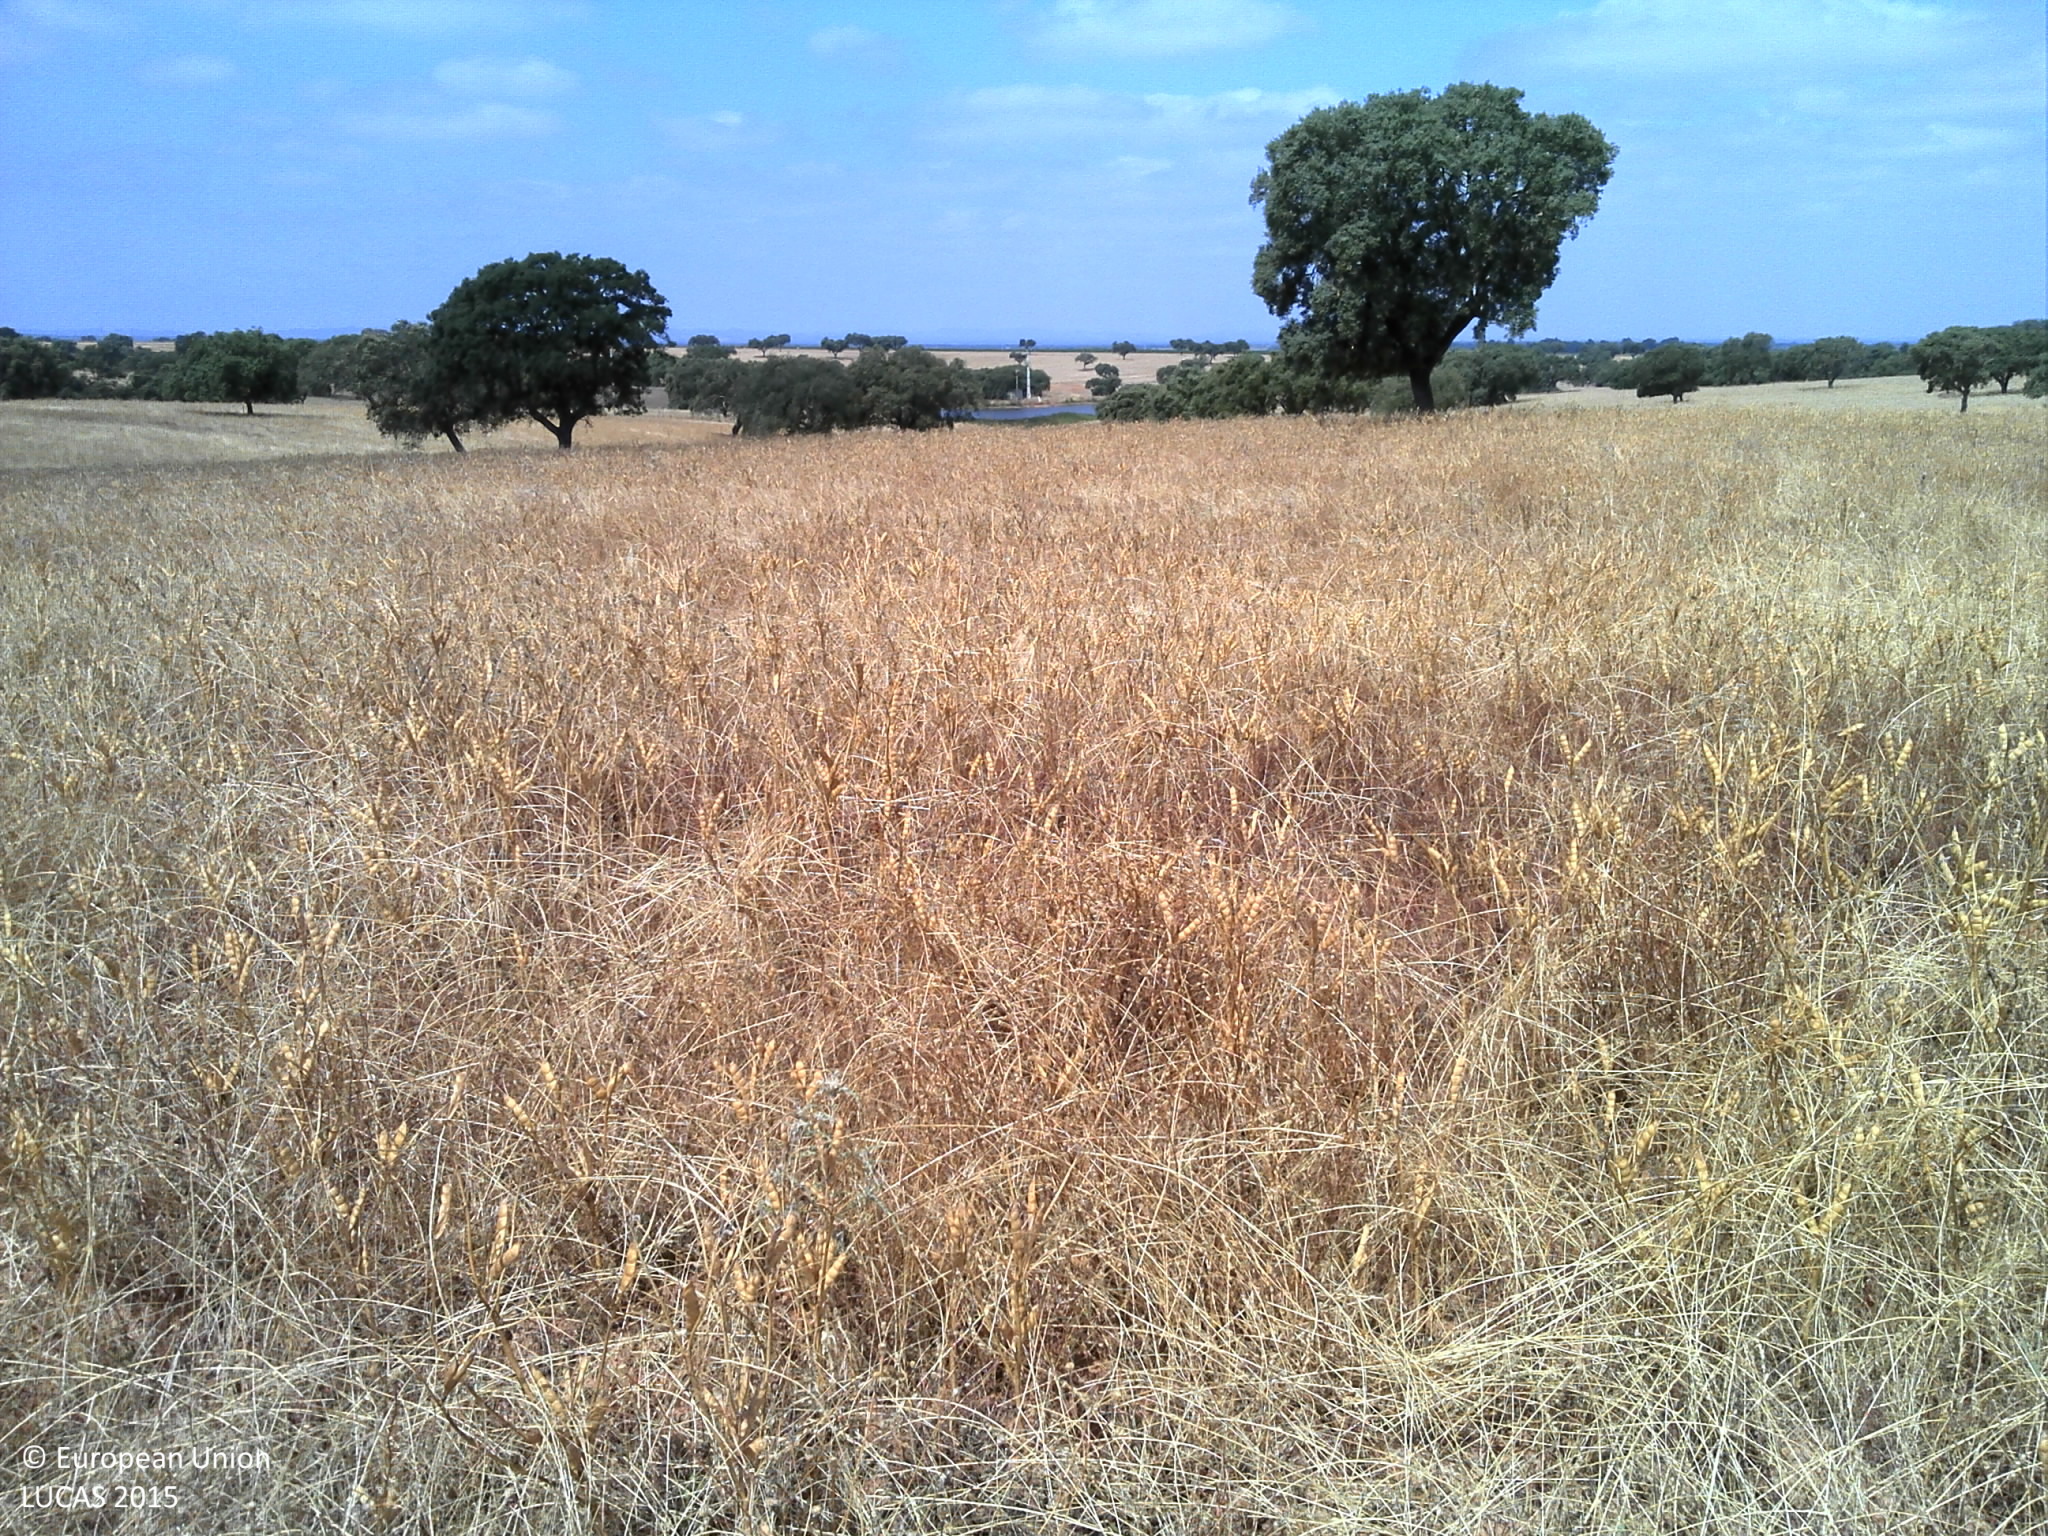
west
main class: Grassland
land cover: Grassland without tree/shrub cover
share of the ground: > 75 %
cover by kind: herbaceous plants 90 %, unconsolidated bare surface 10 %
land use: Agriculture (excluding fallow land and kitchen gardens)
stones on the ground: < 10 %
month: June
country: PT
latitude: 37.8410
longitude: -8.3189
